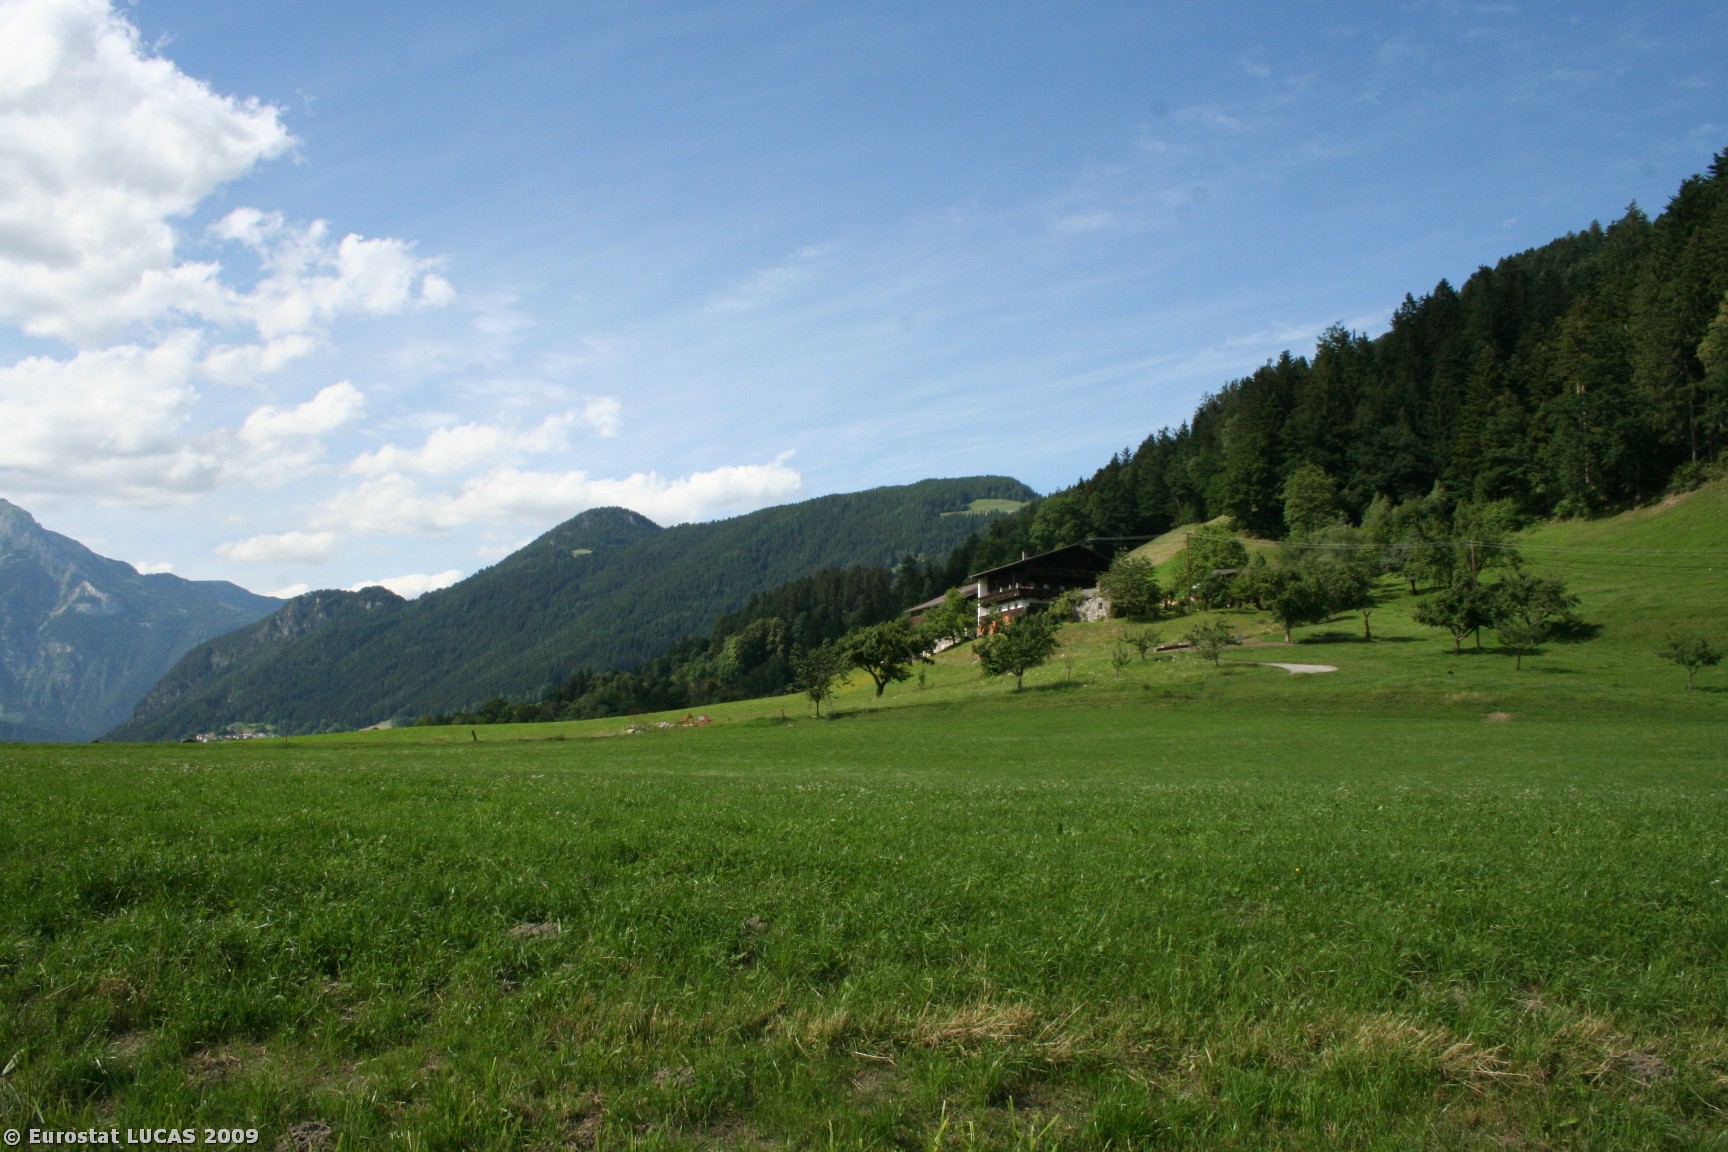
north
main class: Grassland
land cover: Grassland without tree/shrub cover
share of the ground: > 75 %
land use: Agriculture (excluding fallow land and kitchen gardens)
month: June
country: AT
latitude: 47.3616
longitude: 11.8654
